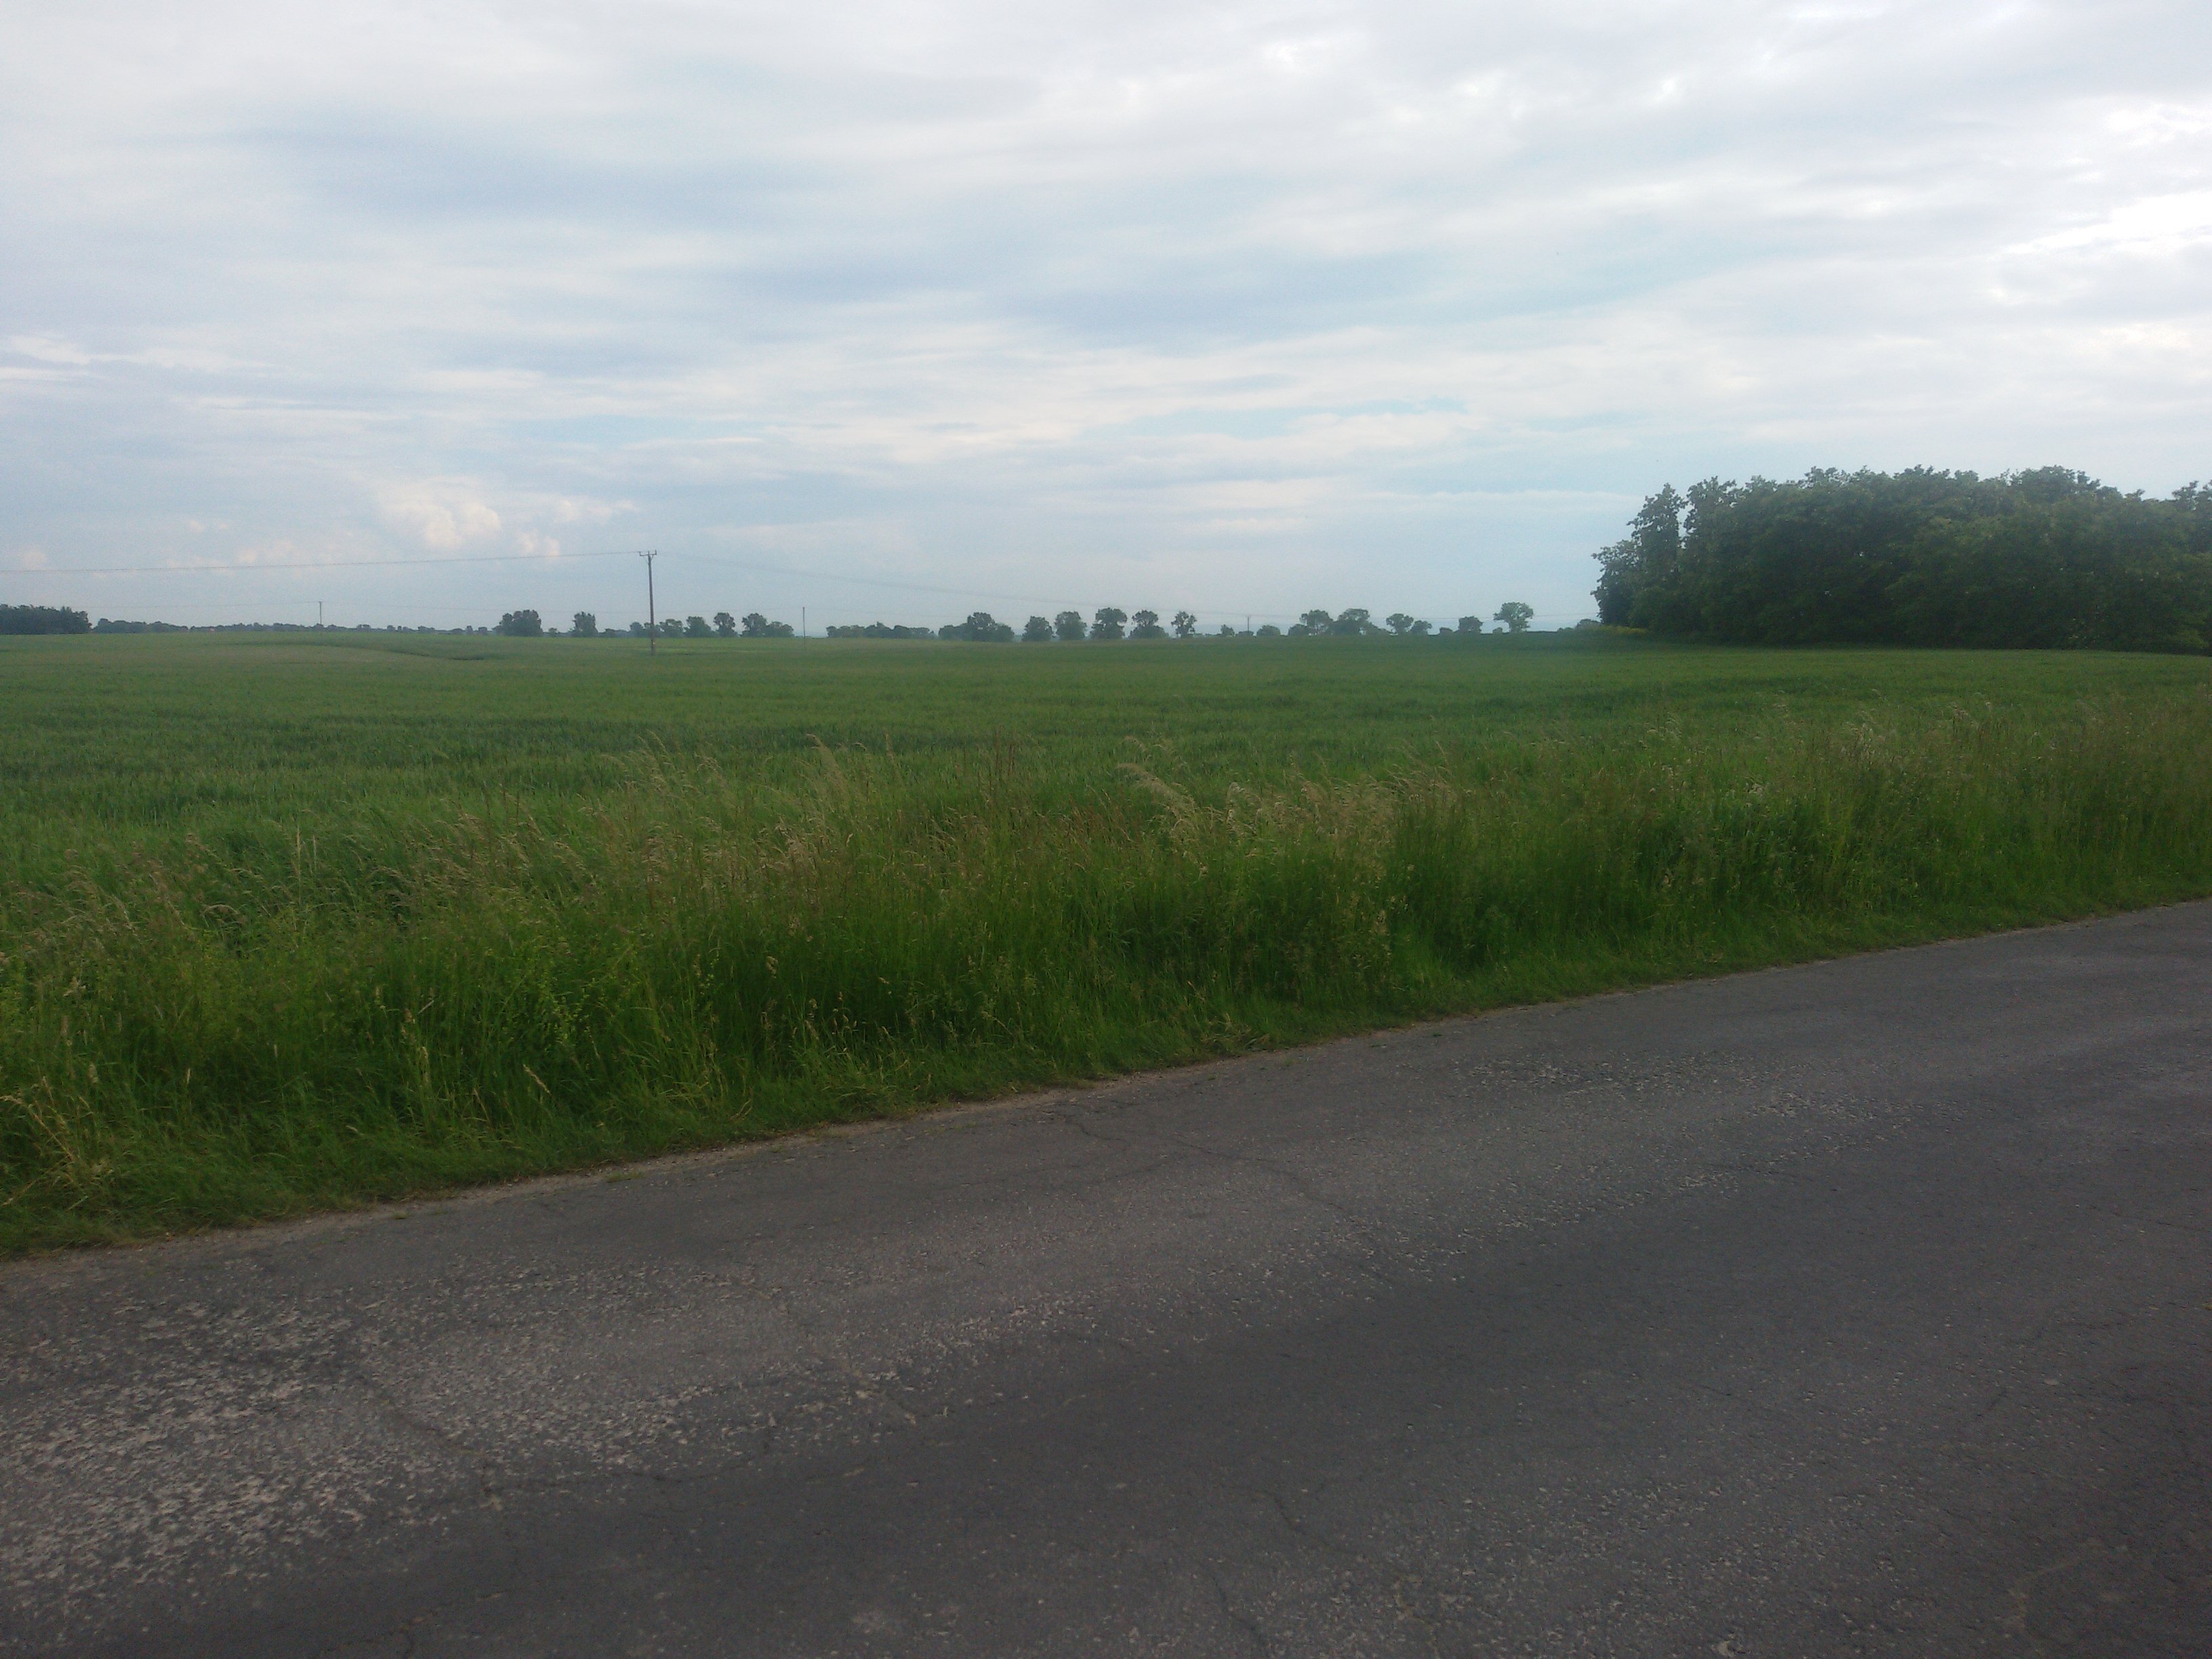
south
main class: Cropland
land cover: Rape and turnip rape
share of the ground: > 75 %
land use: Agriculture (excluding fallow land and kitchen gardens)
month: June
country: PL
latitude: 50.5056
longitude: 17.6416
